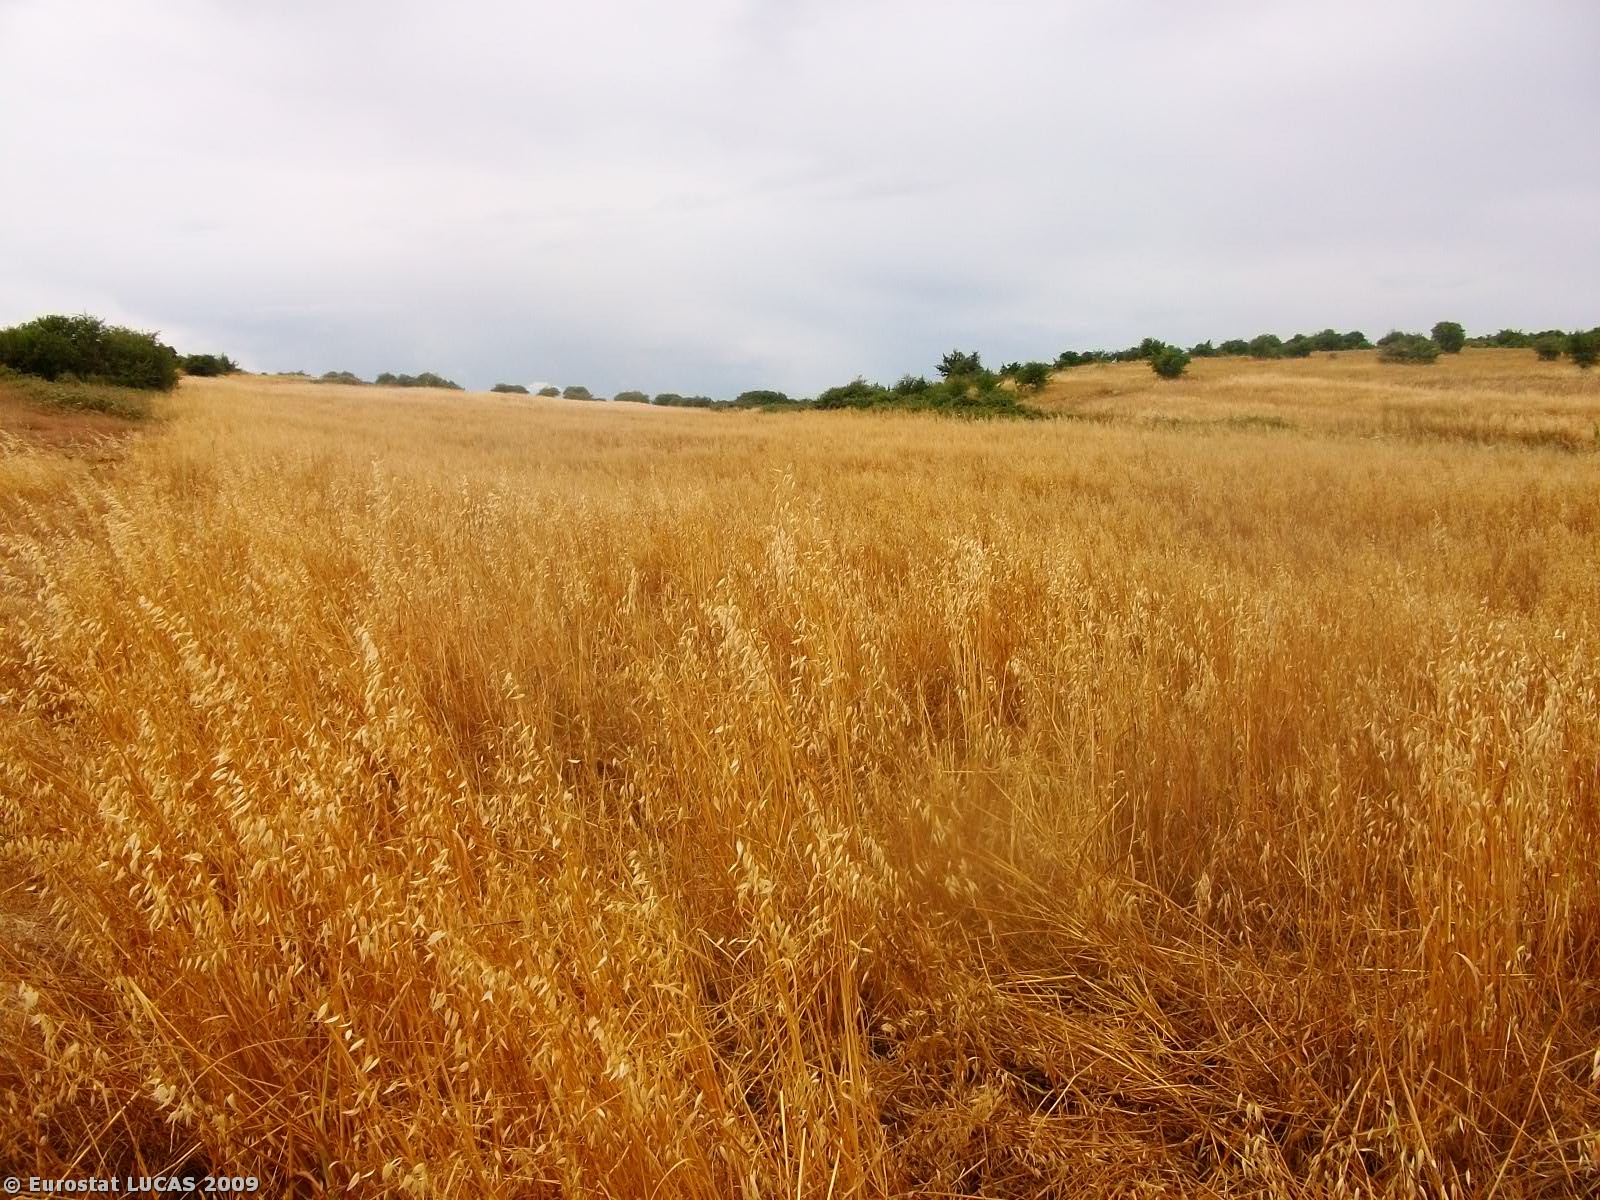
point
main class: Cropland
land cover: Durum wheat
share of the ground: > 75 %
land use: Agriculture (excluding fallow land and kitchen gardens)
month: June
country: GR
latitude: 40.9697
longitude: 22.7353
